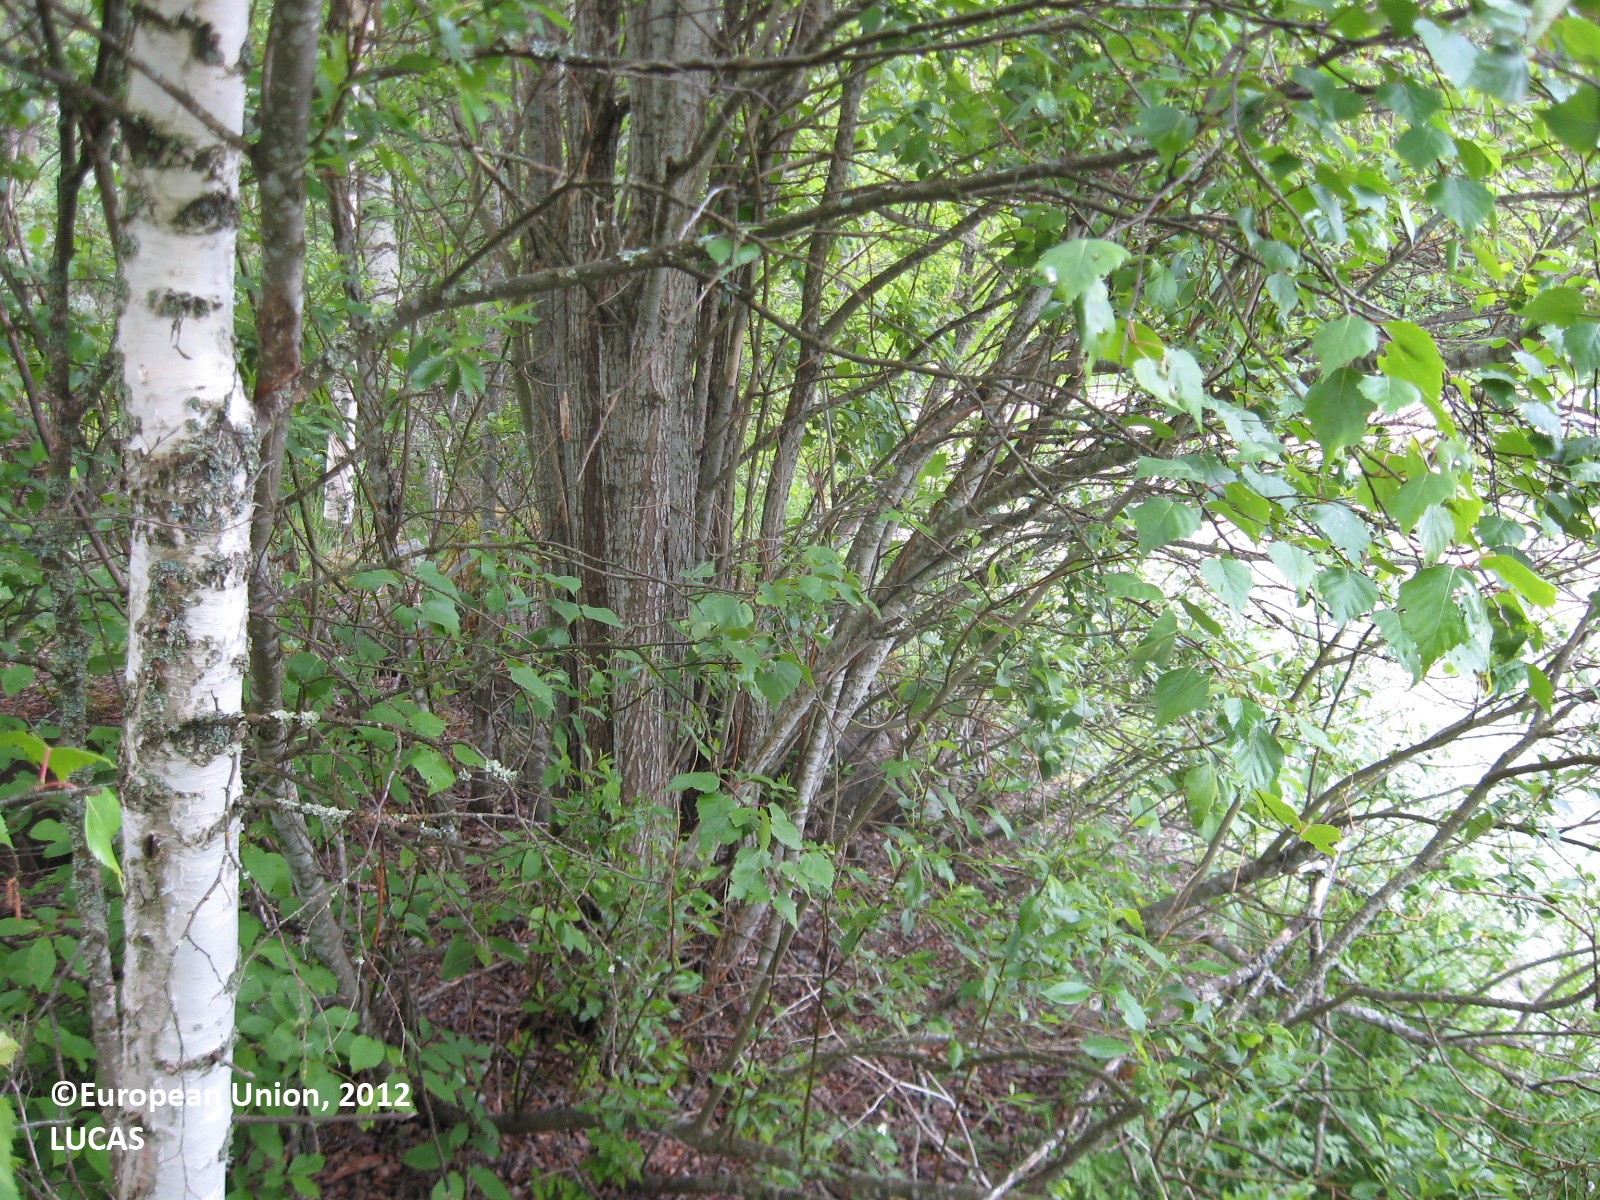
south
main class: Woodland
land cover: Broadleaved woodland
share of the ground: > 75 %
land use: Forestry
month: June
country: FI
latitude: 63.1037
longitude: 21.7114
